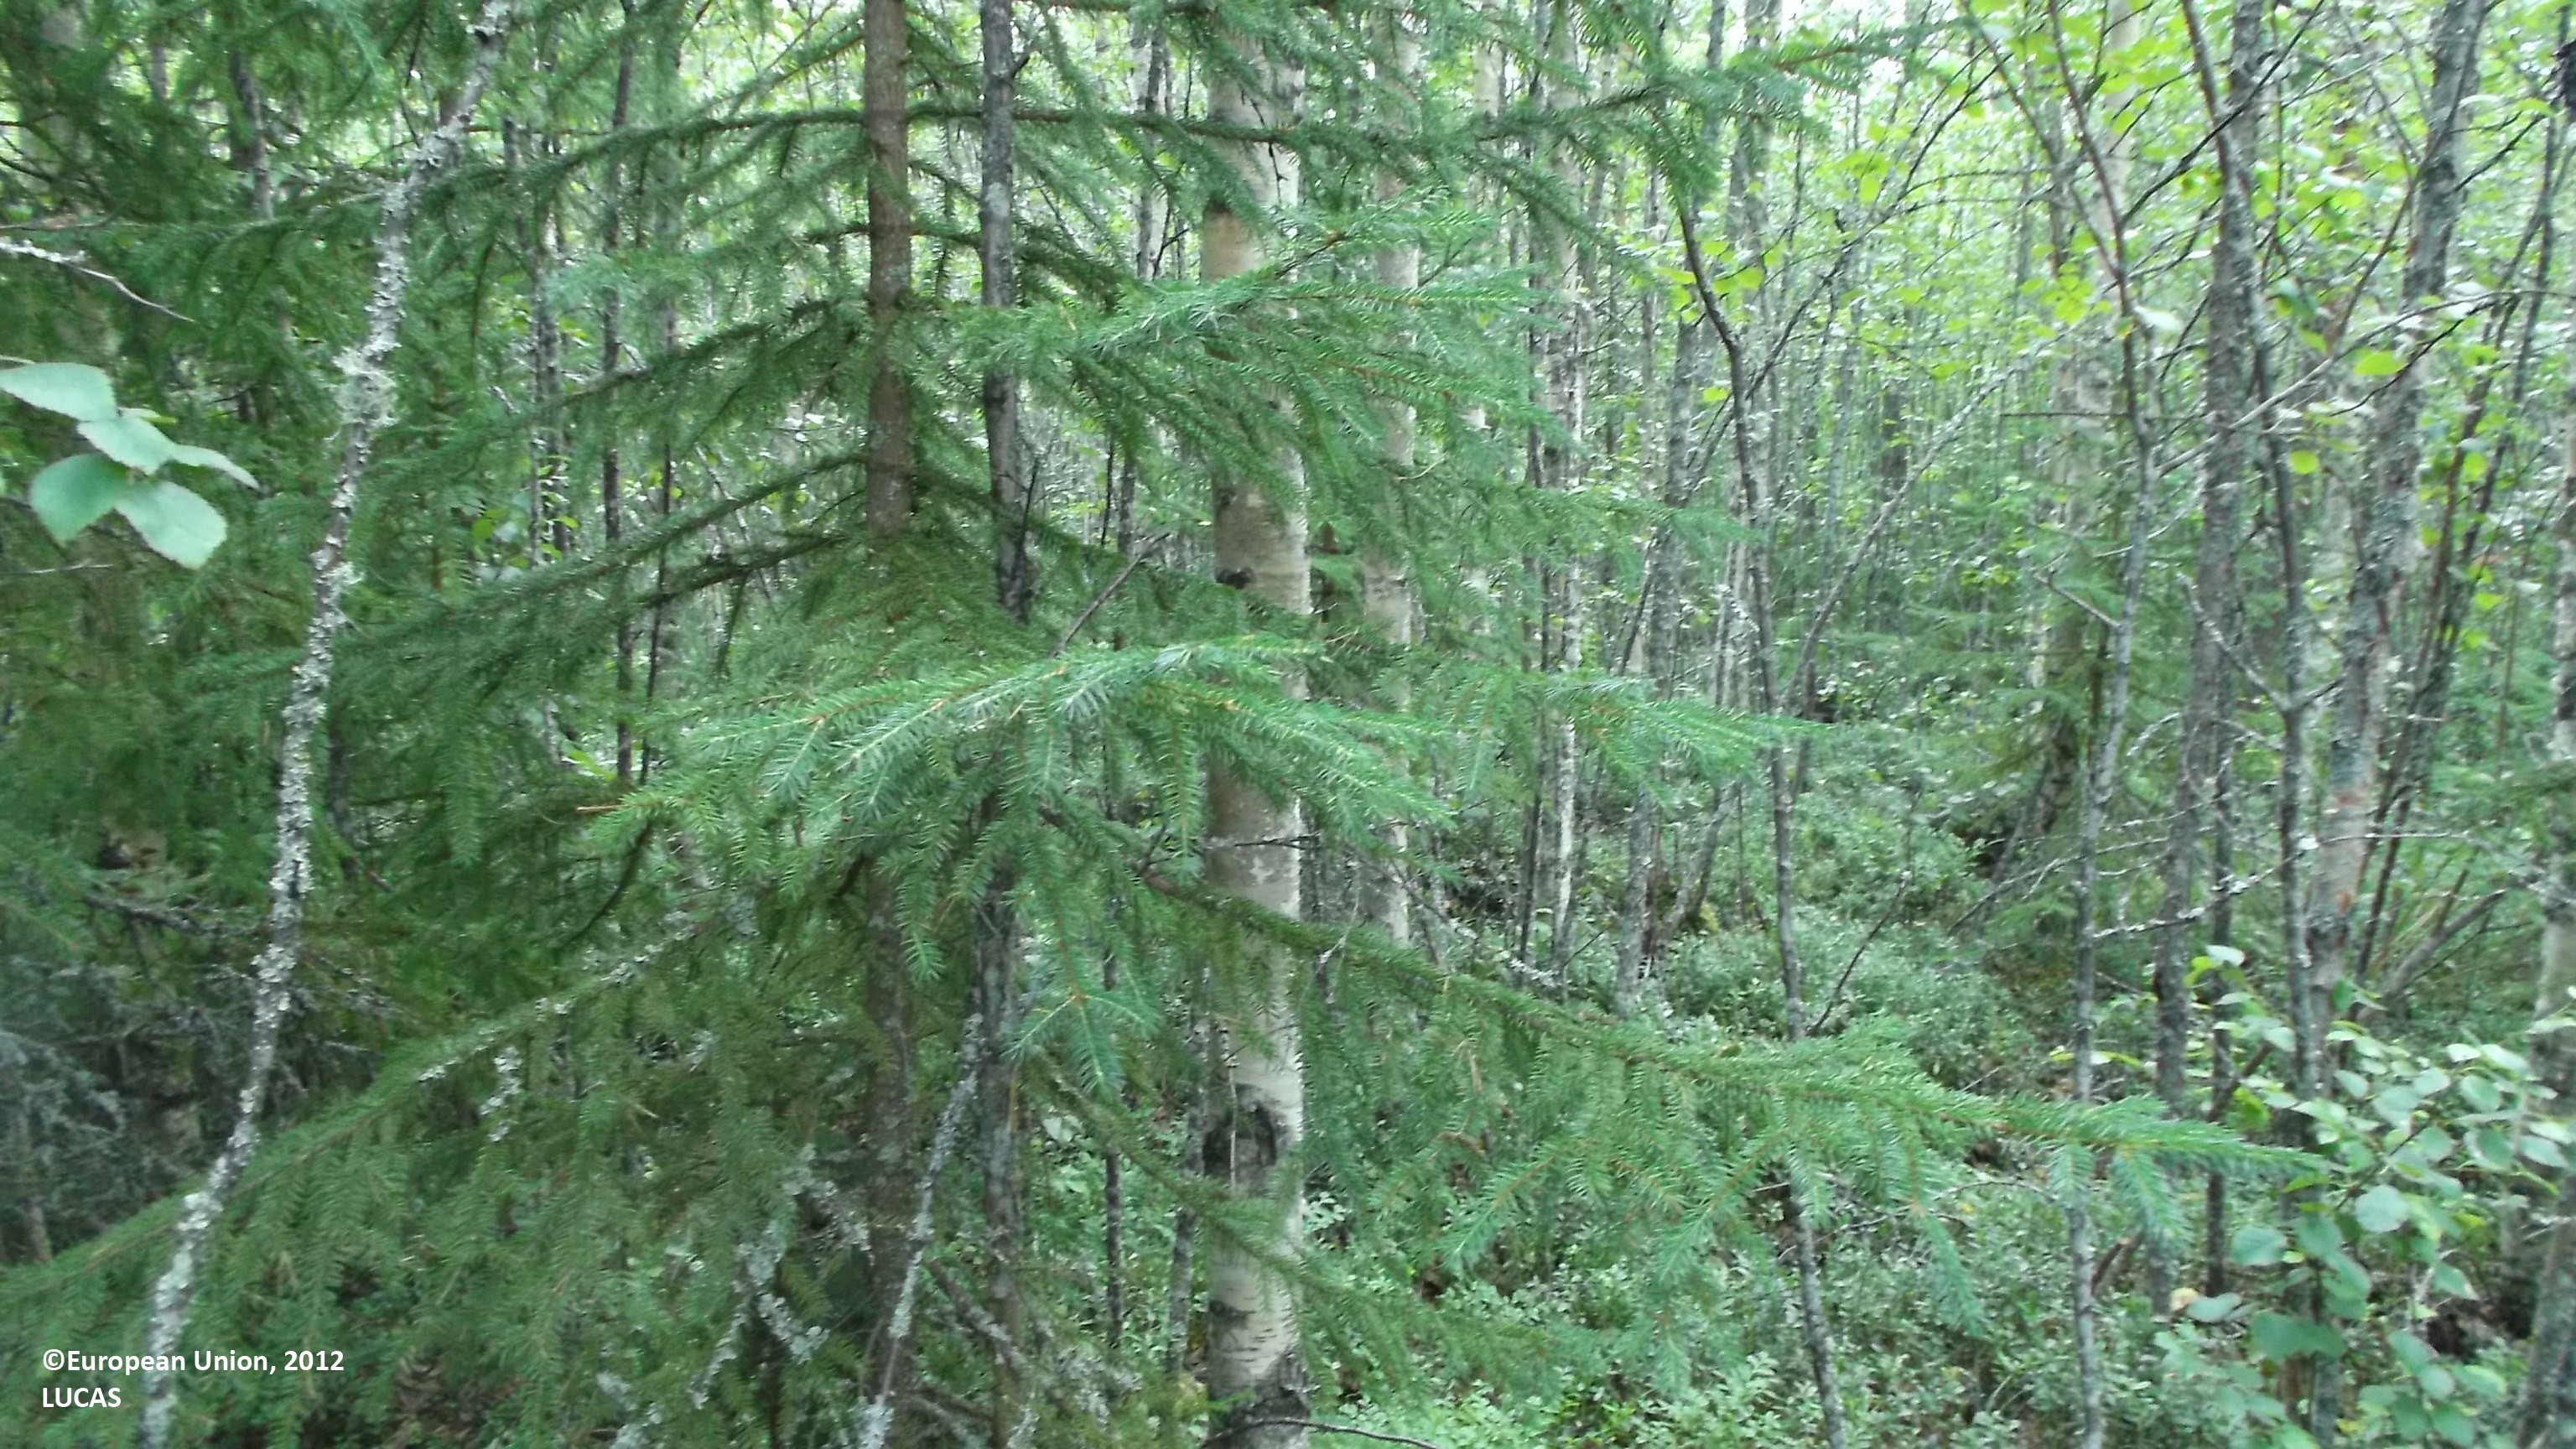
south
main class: Woodland
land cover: Spruce dominated mixed woodland
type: boreal forest
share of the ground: > 75 %
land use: Forestry
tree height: > 5 m
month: July
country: FI
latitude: 63.5915
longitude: 22.9296
